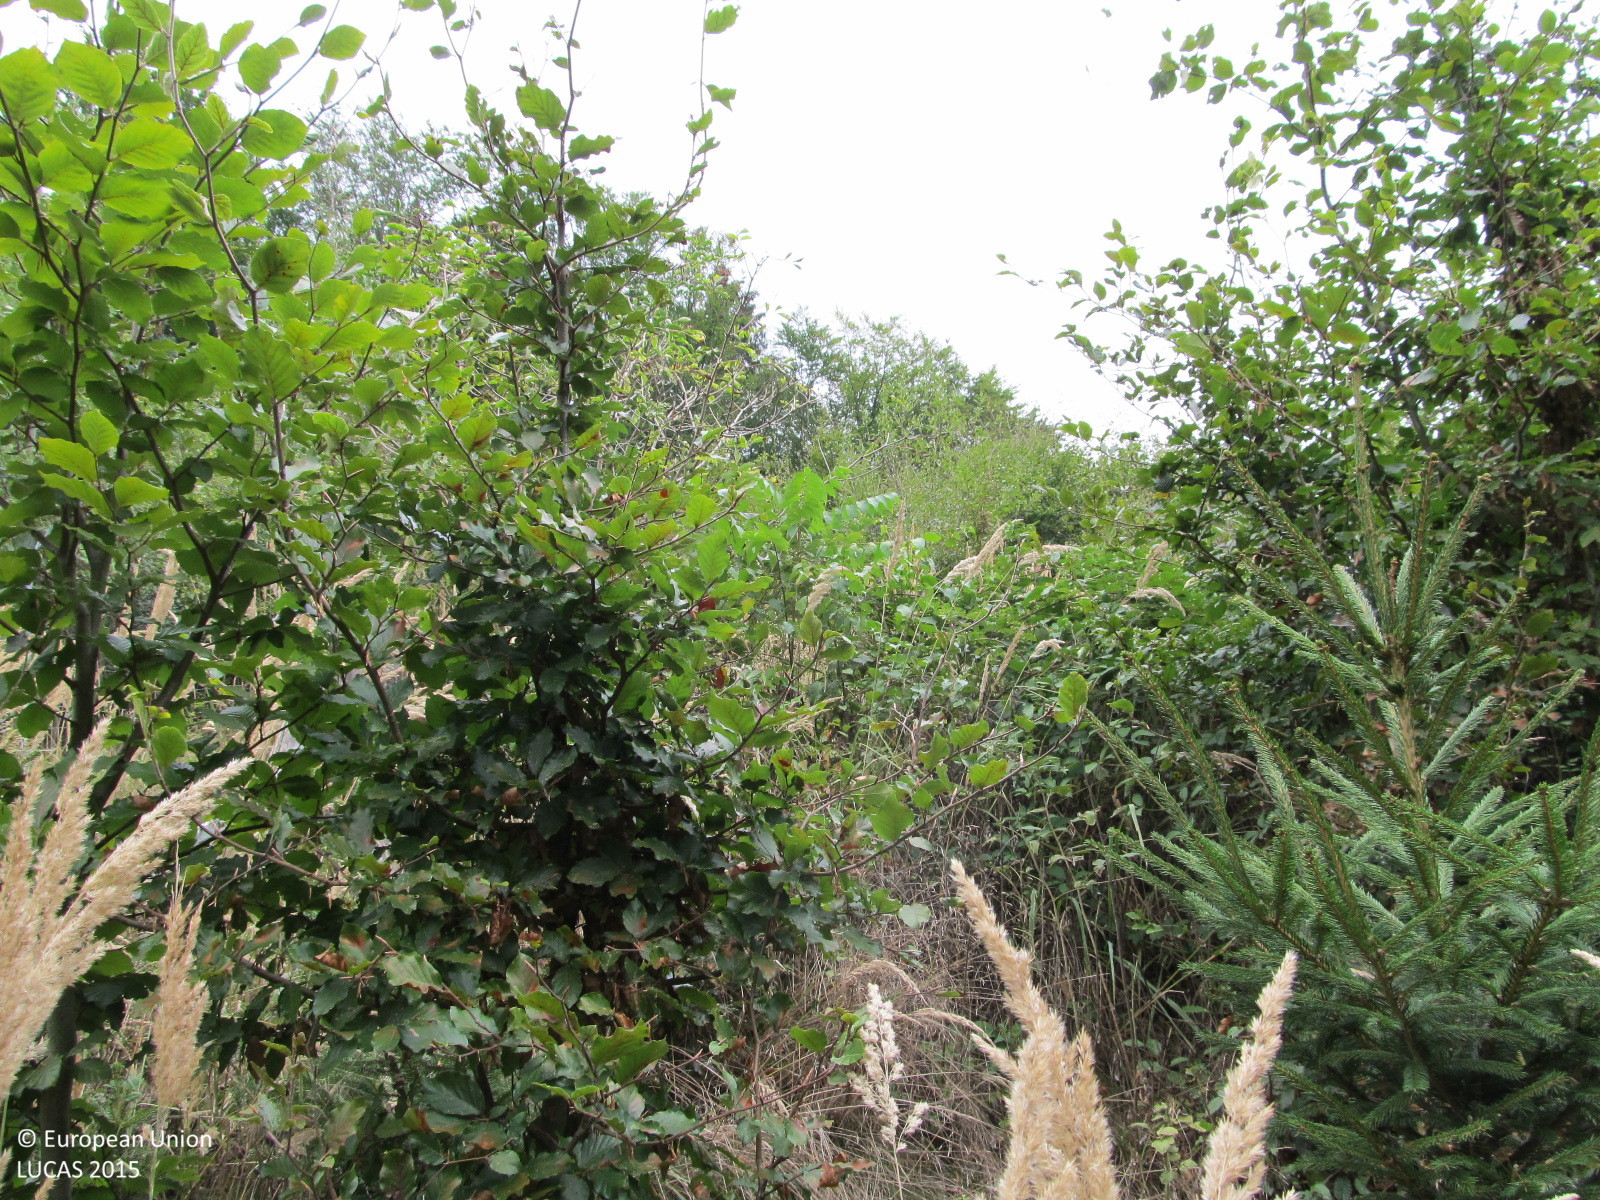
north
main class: Woodland
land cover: Broadleaved woodland
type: hemiboreal forest and nemoral coniferous forest and mixed broadleaved-coniferous forest
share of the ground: > 75 %
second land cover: Spontaneously vegetated surfaces
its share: 10 - 25 %
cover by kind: broadleaved forest trees 80 %, herbaceous plants 20 %
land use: Forestry
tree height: < 5 m
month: September
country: AT
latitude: 48.3391
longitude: 15.4934
